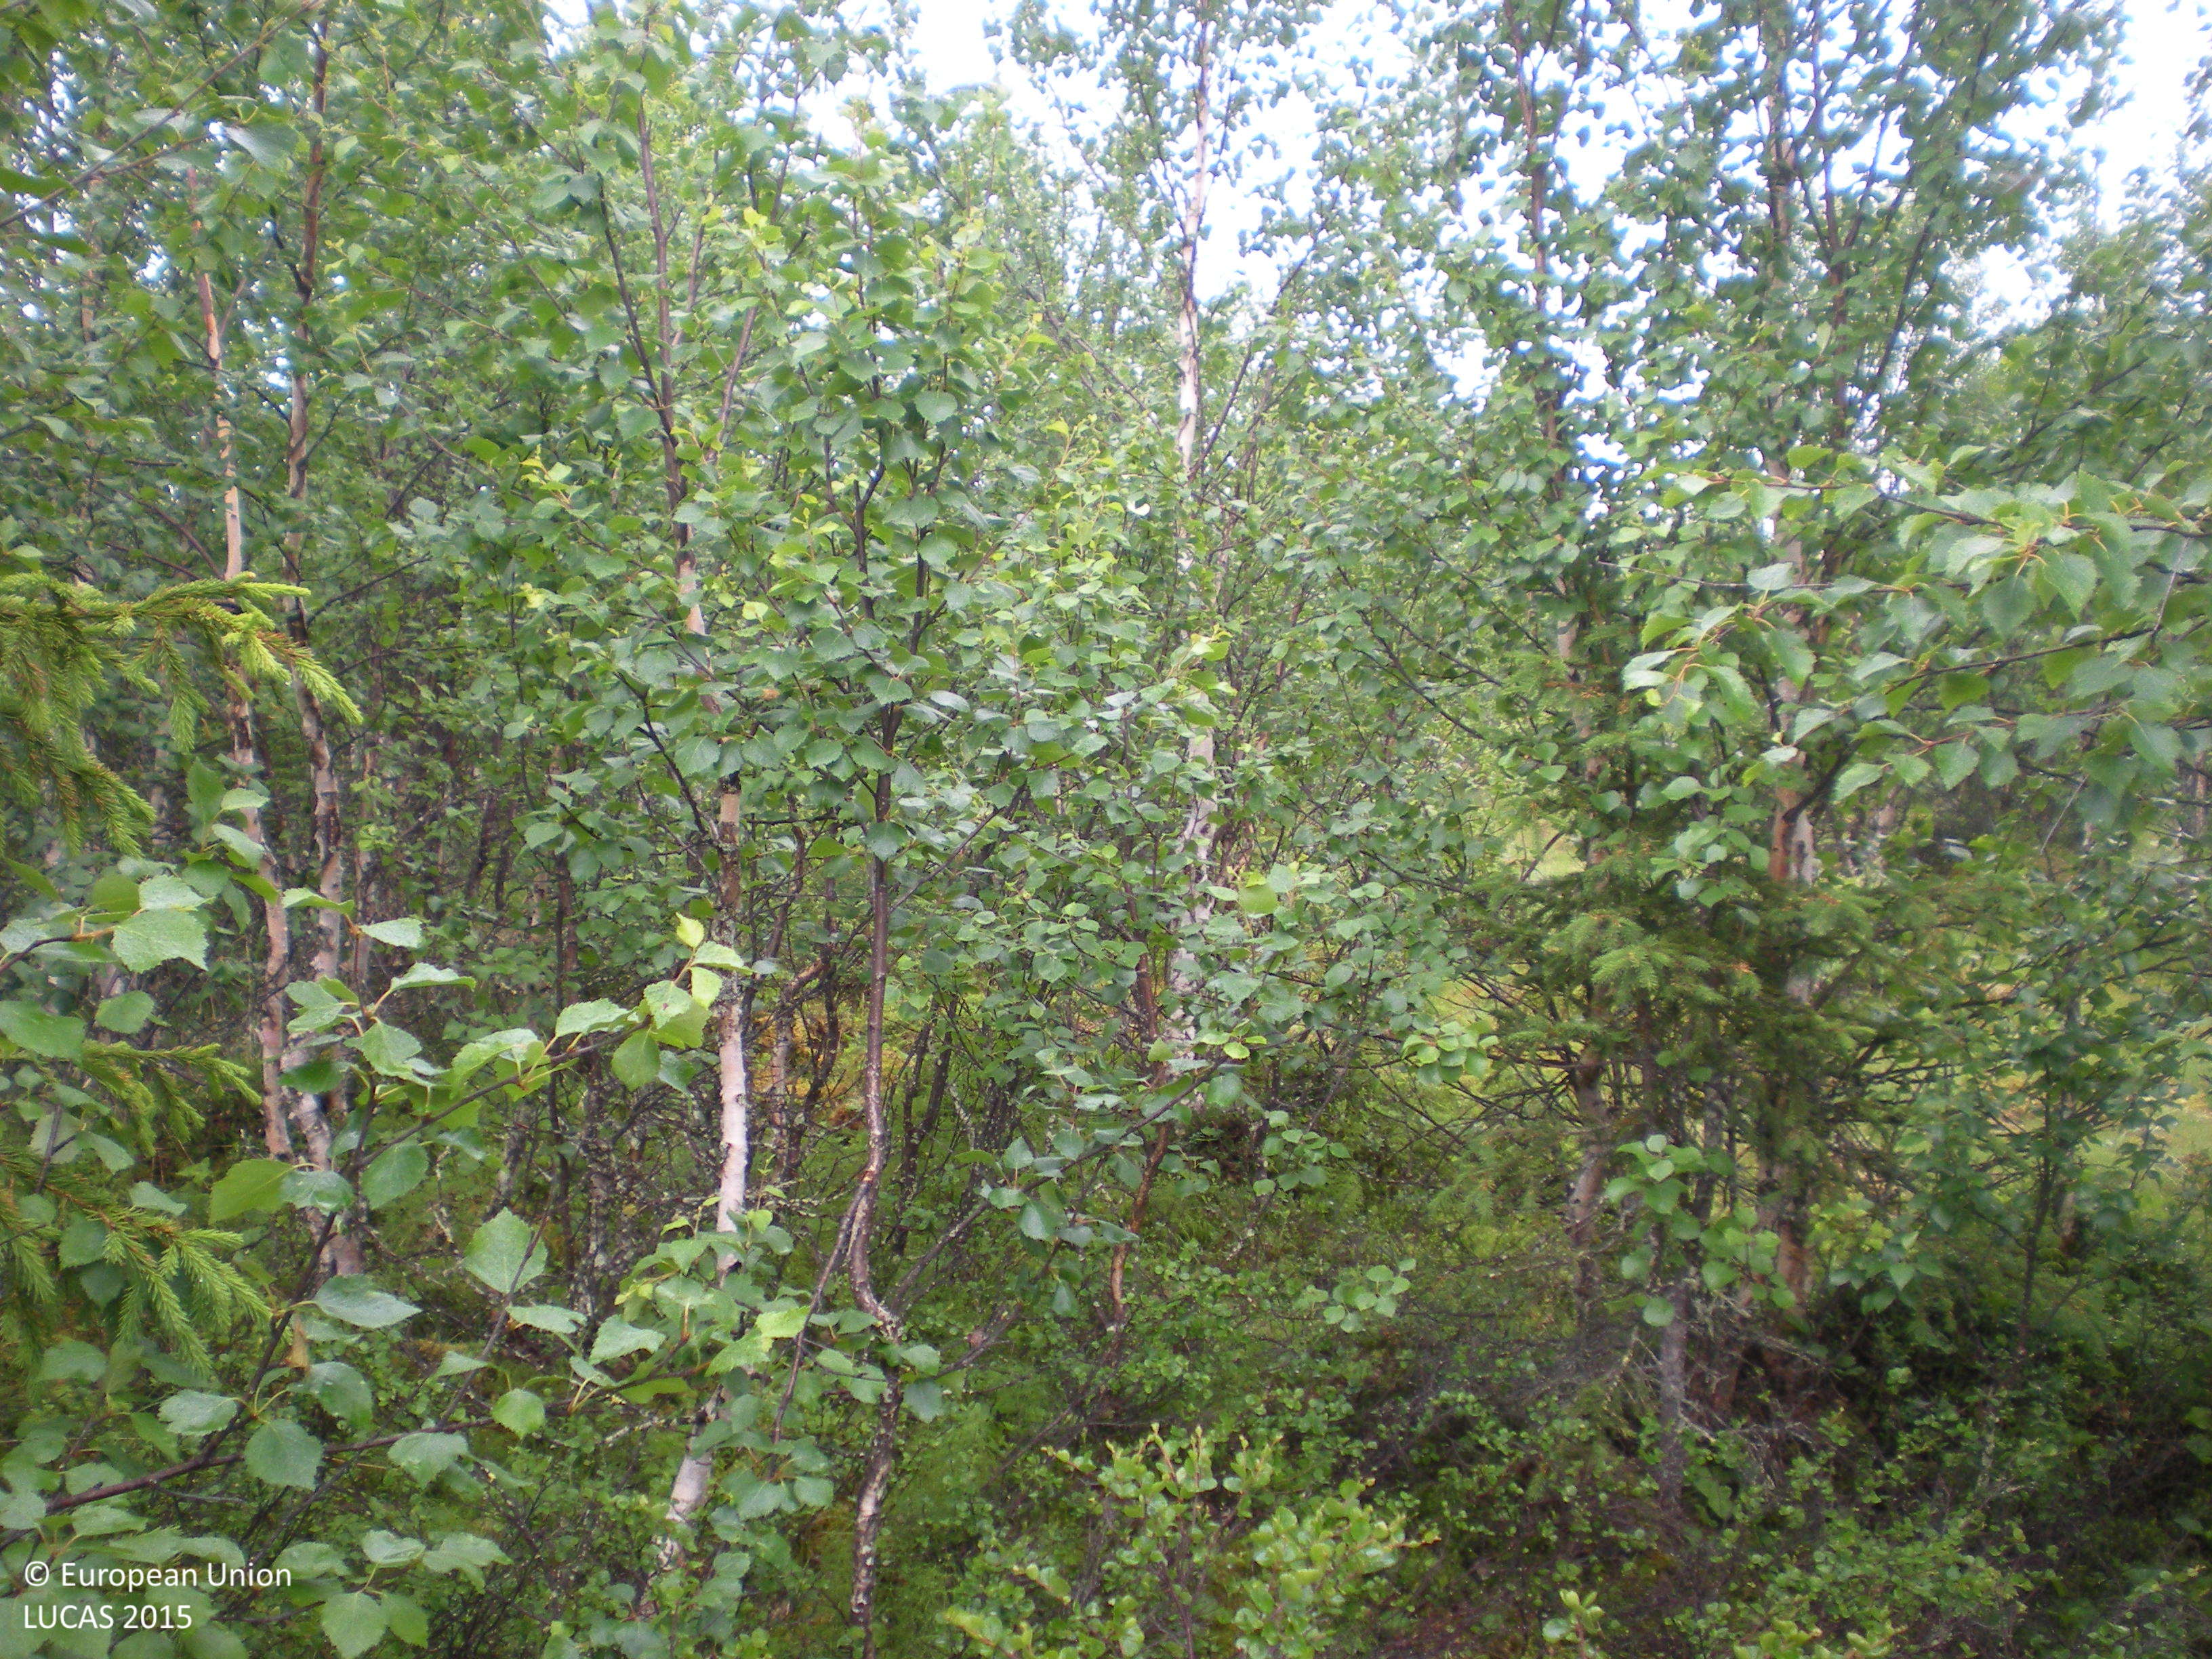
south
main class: Woodland
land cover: Spruce dominated mixed woodland
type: boreal forest
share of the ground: 50 - 75 %
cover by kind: broadleaved forest trees 55 %, coniferous forest trees 20 %, herbaceous plants 10 %, lichens and mosses 10 %, shrubs 5 %
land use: Forestry
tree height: > 5 m
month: July
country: SE
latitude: 65.7765
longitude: 17.2315
